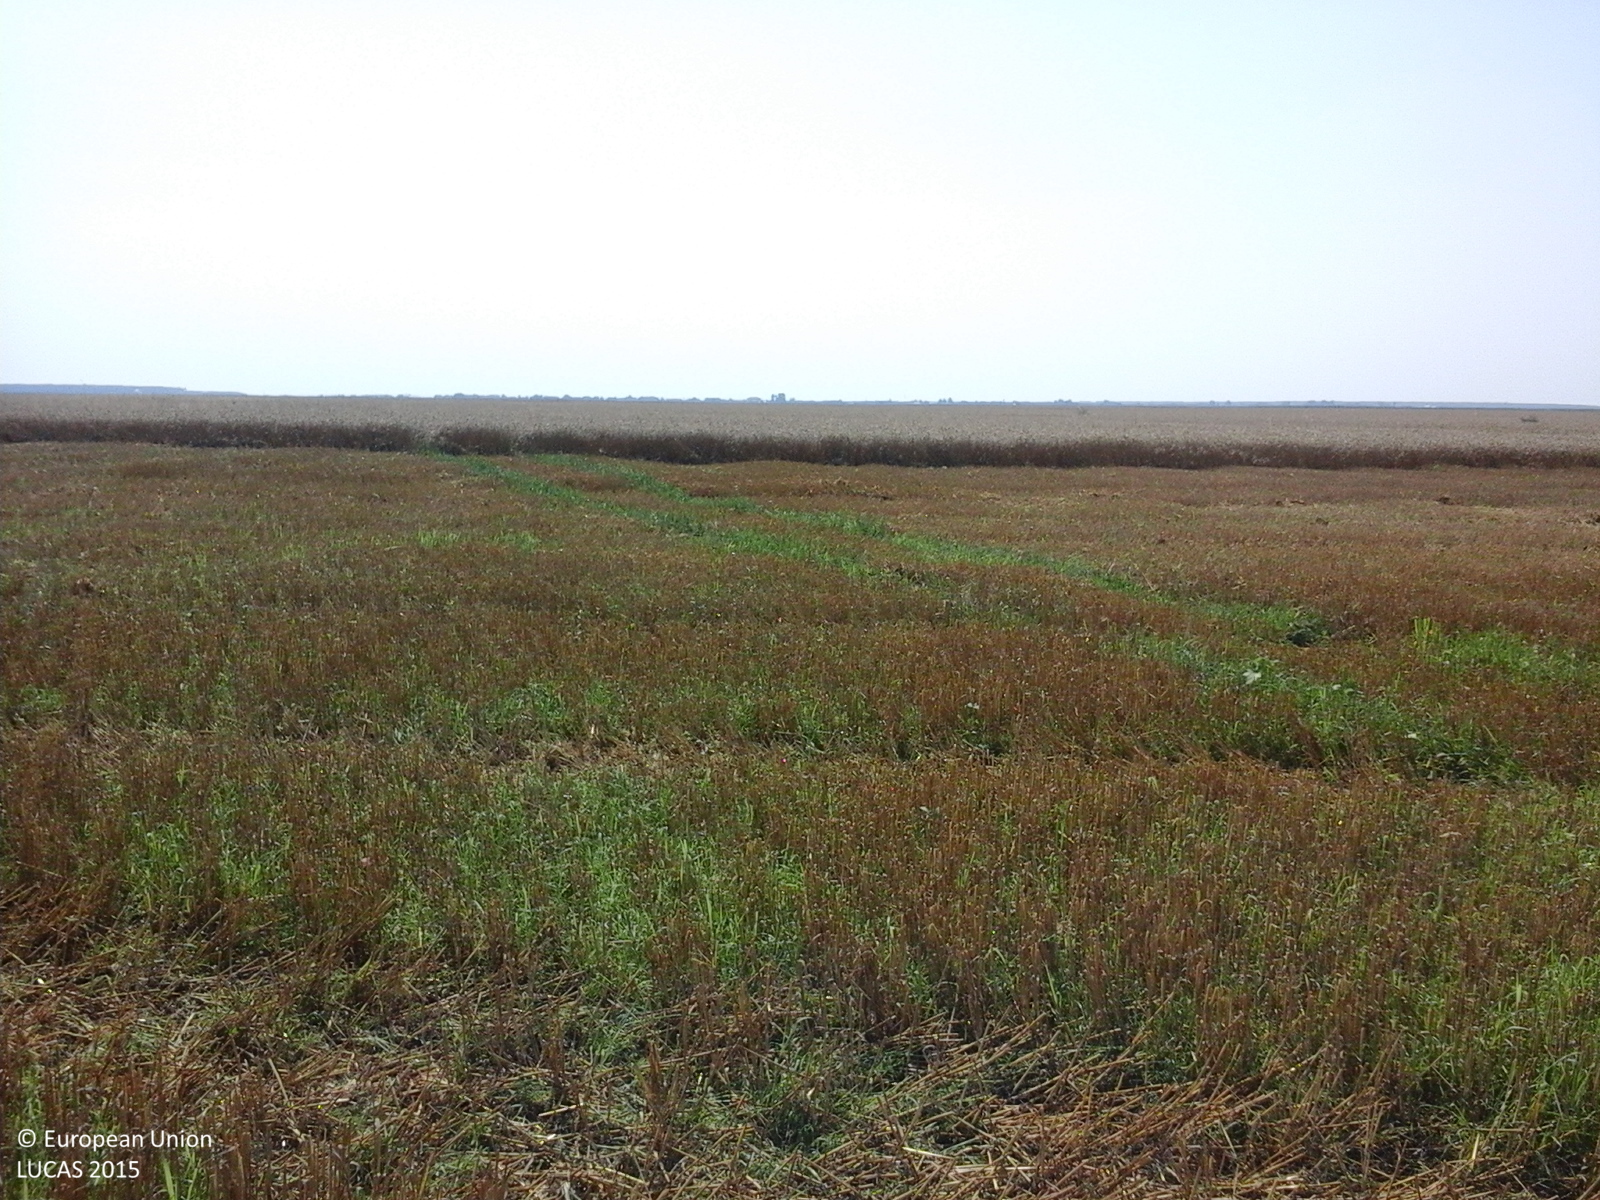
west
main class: Cropland
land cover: Common wheat
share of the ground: < 10 %
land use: Agriculture (excluding fallow land and kitchen gardens)
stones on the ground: < 10 %
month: July
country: RO
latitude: 44.7091
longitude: 25.5572
